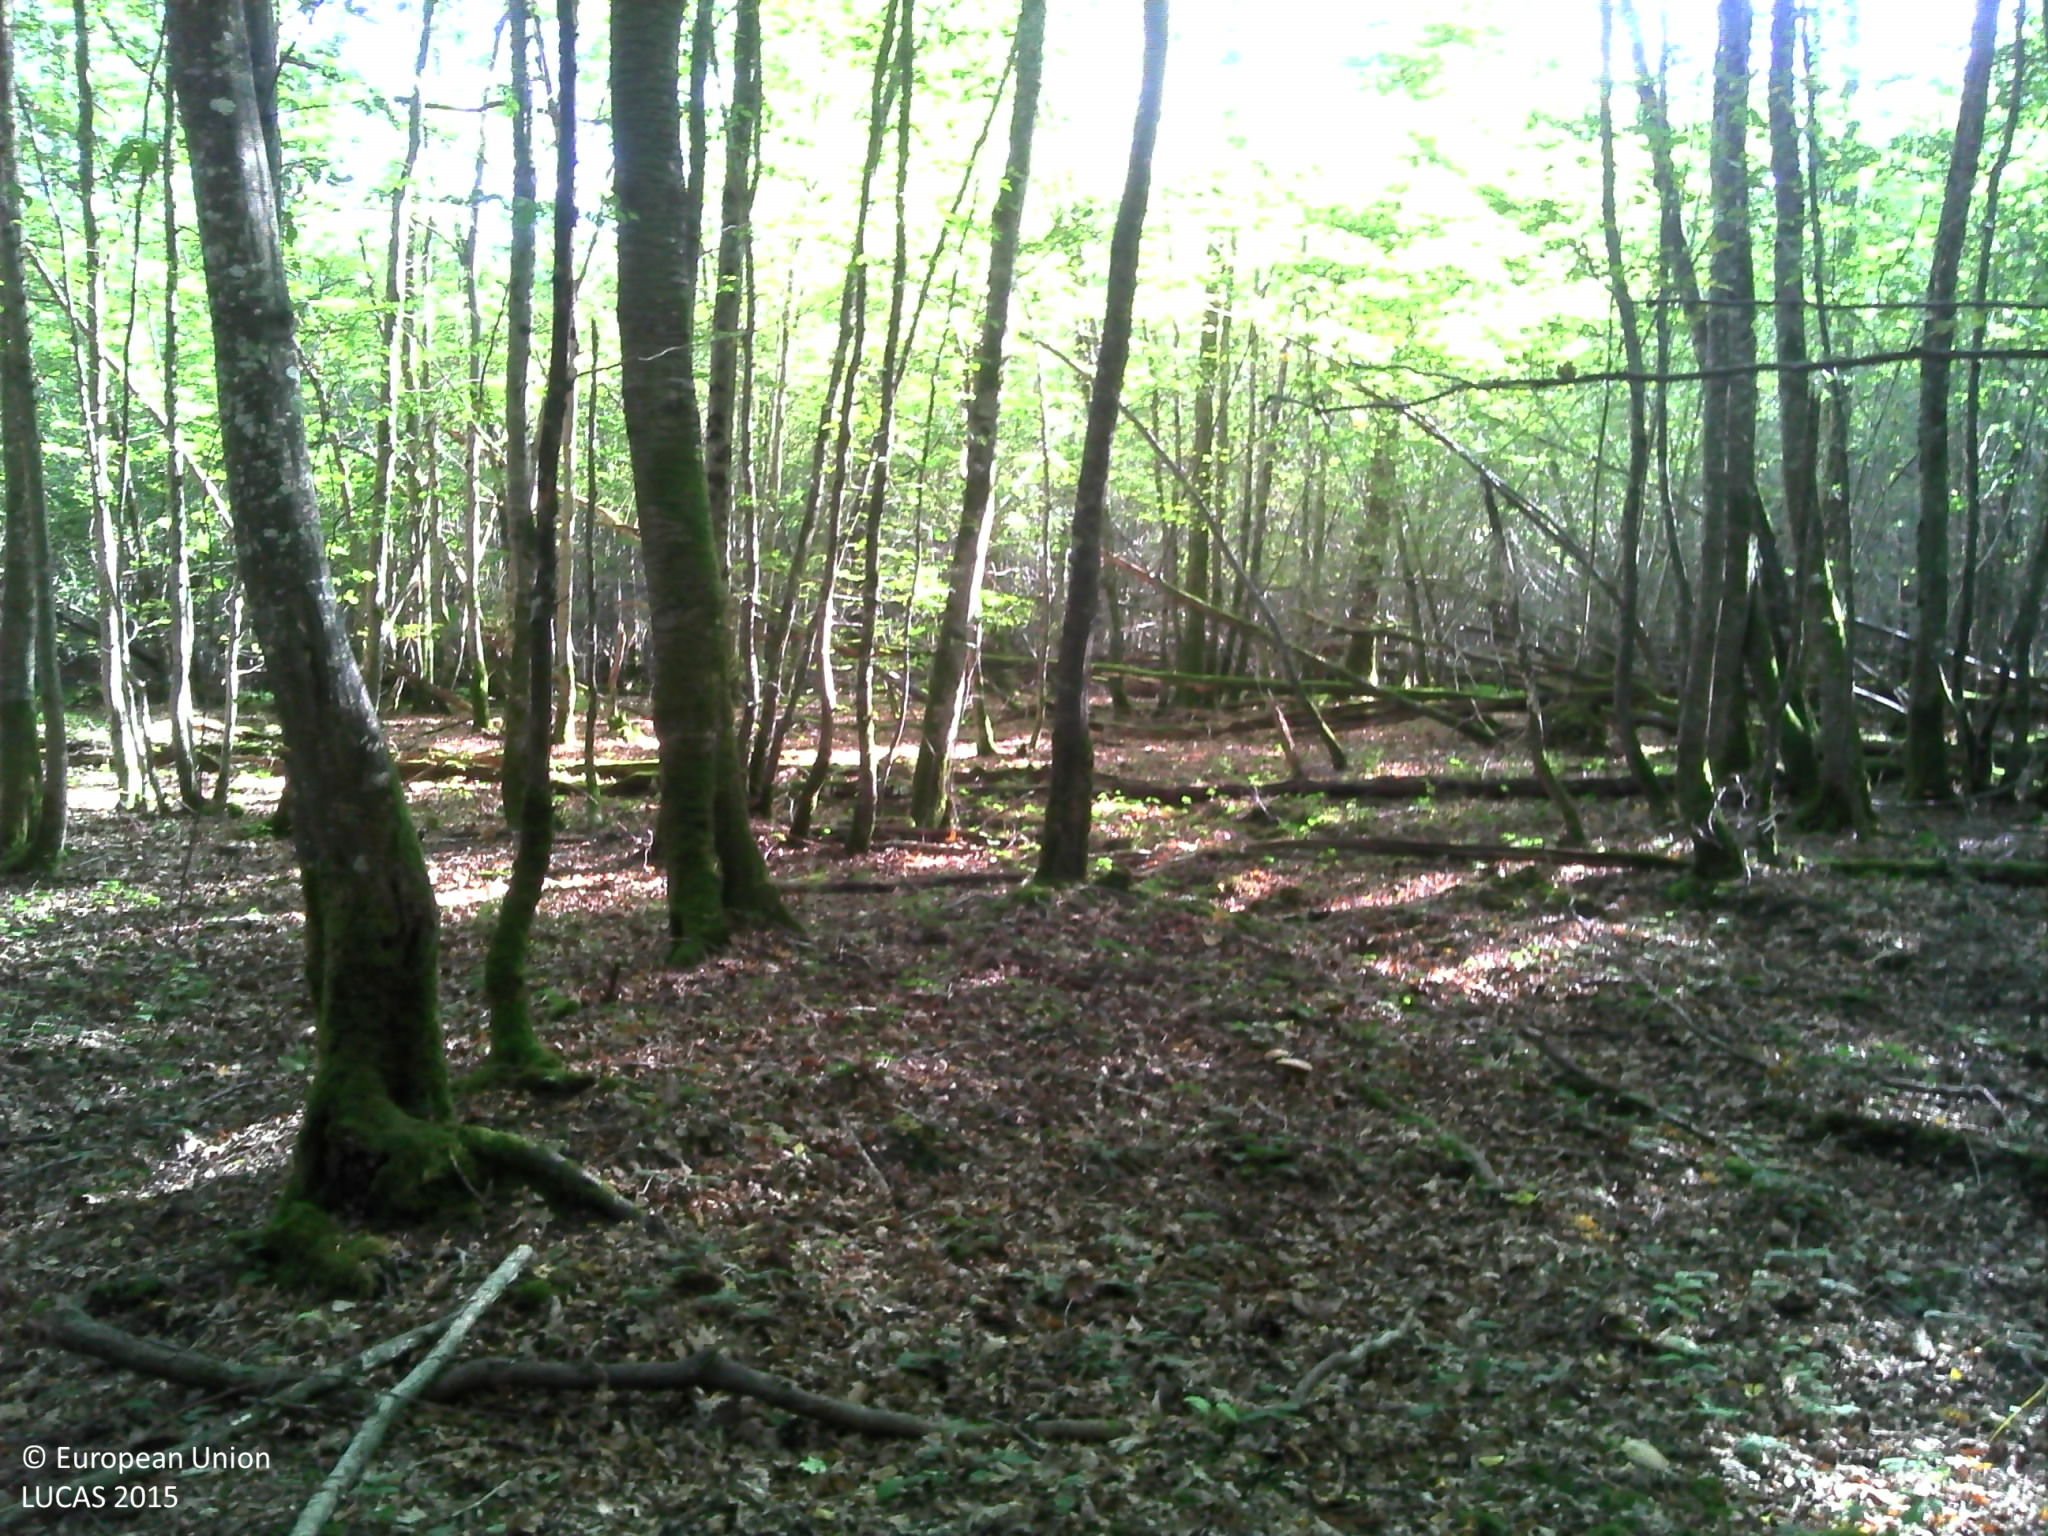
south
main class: Woodland
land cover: Broadleaved woodland
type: mesophytic deciduous forest
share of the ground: > 75 %
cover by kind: broadleaved forest trees 90 %, herbaceous plants 5 %, lichens and mosses 5 %
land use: Forestry
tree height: > 5 m
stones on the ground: < 10 %
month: September
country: FR
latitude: 48.1423
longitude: 3.8541
